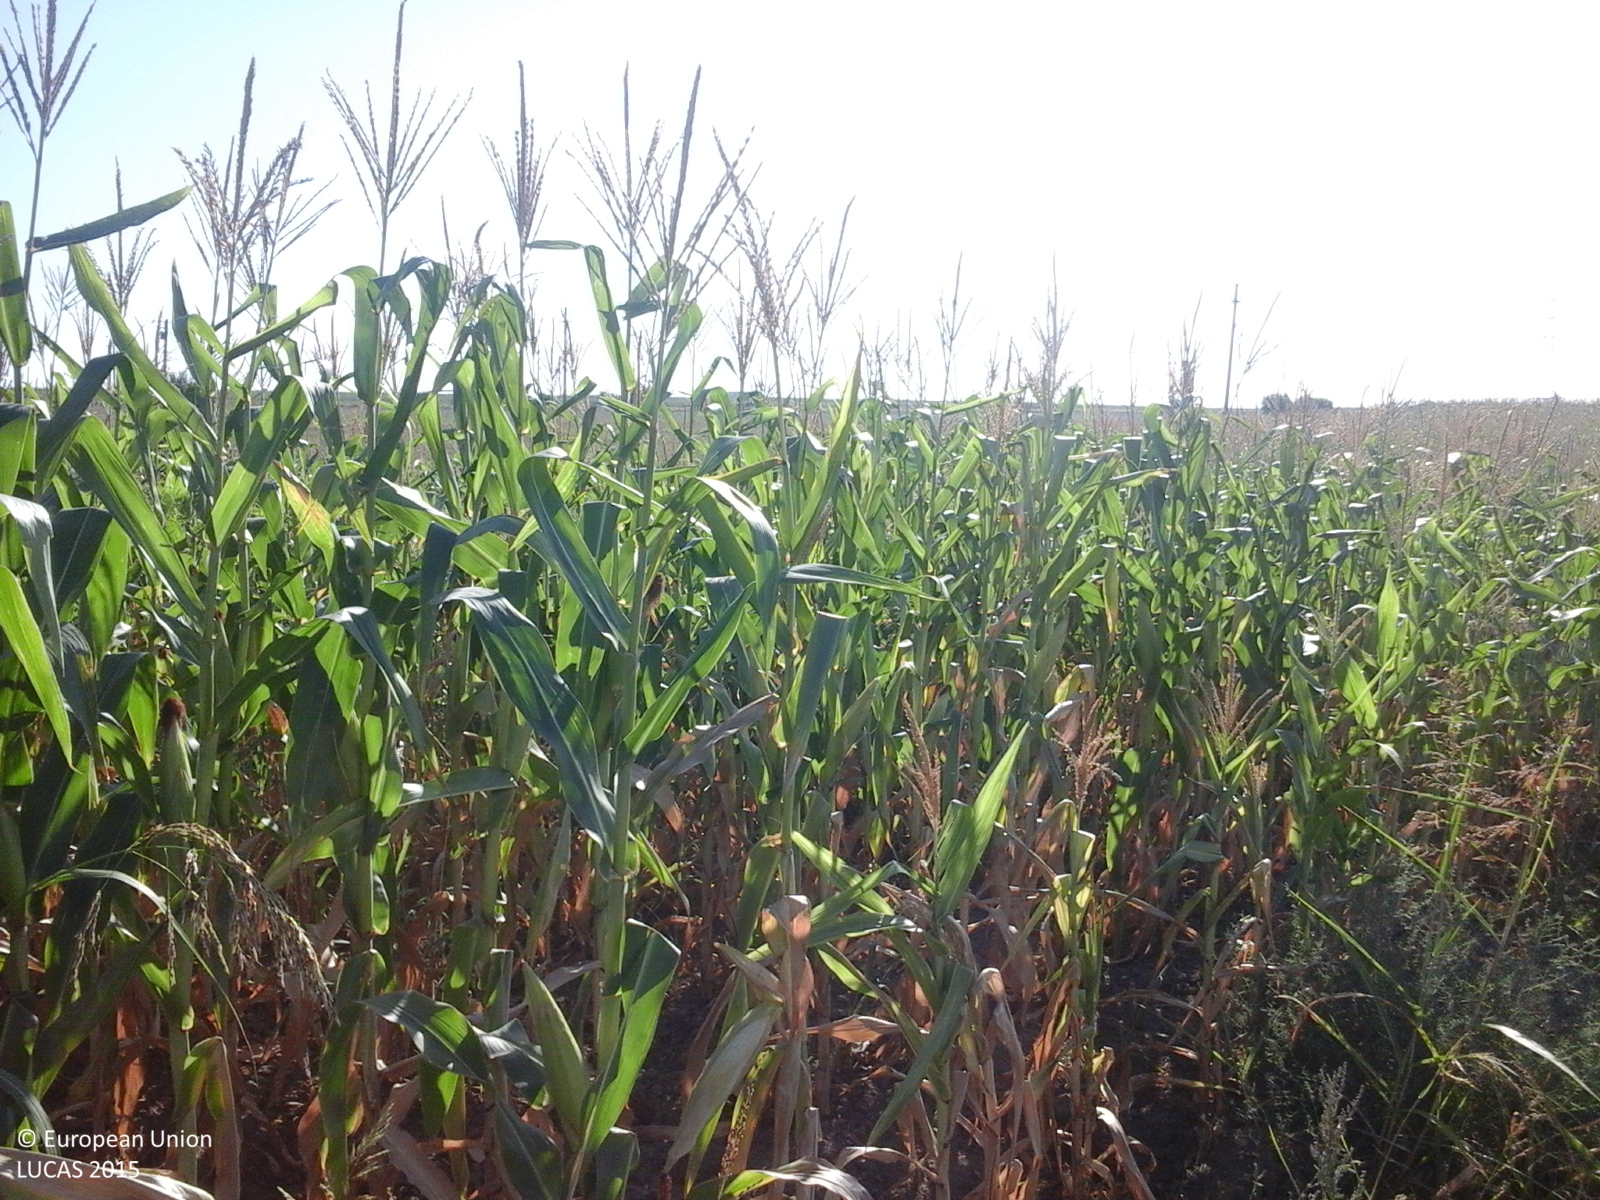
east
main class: Cropland
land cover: Maize
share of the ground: > 75 %
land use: Agriculture (excluding fallow land and kitchen gardens)
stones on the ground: < 10 %
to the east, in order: Maize; Common wheat; Grass margins; Tracks; Grass margins; Rape and turnip rape; Electric lines; Rape and turnip rape; Grassland without tree/shrub cover; Paved roads, cycling and walking lanes
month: August
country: RO
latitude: 44.6246
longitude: 28.0976
